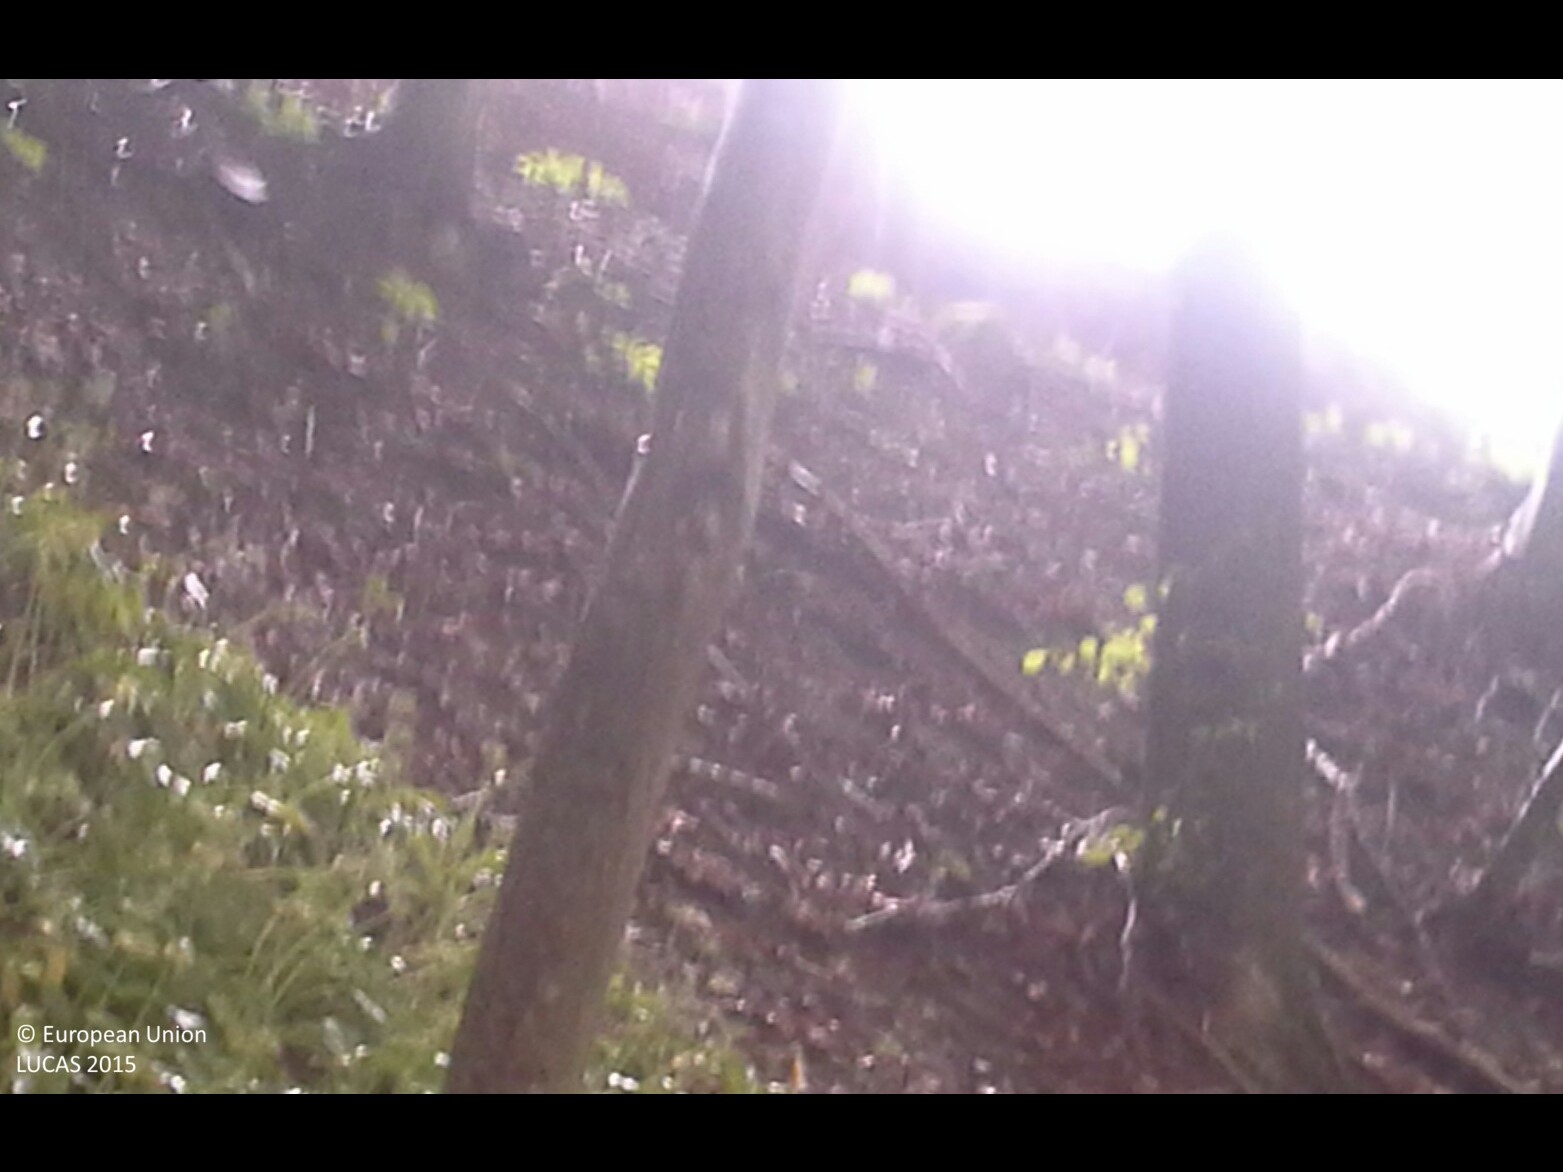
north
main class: Woodland
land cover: Broadleaved woodland
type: mesophytic deciduous forest
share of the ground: > 75 %
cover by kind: broadleaved forest trees 100 %
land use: Forestry
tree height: > 5 m
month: June
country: AT
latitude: 48.0059
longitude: 14.4904
